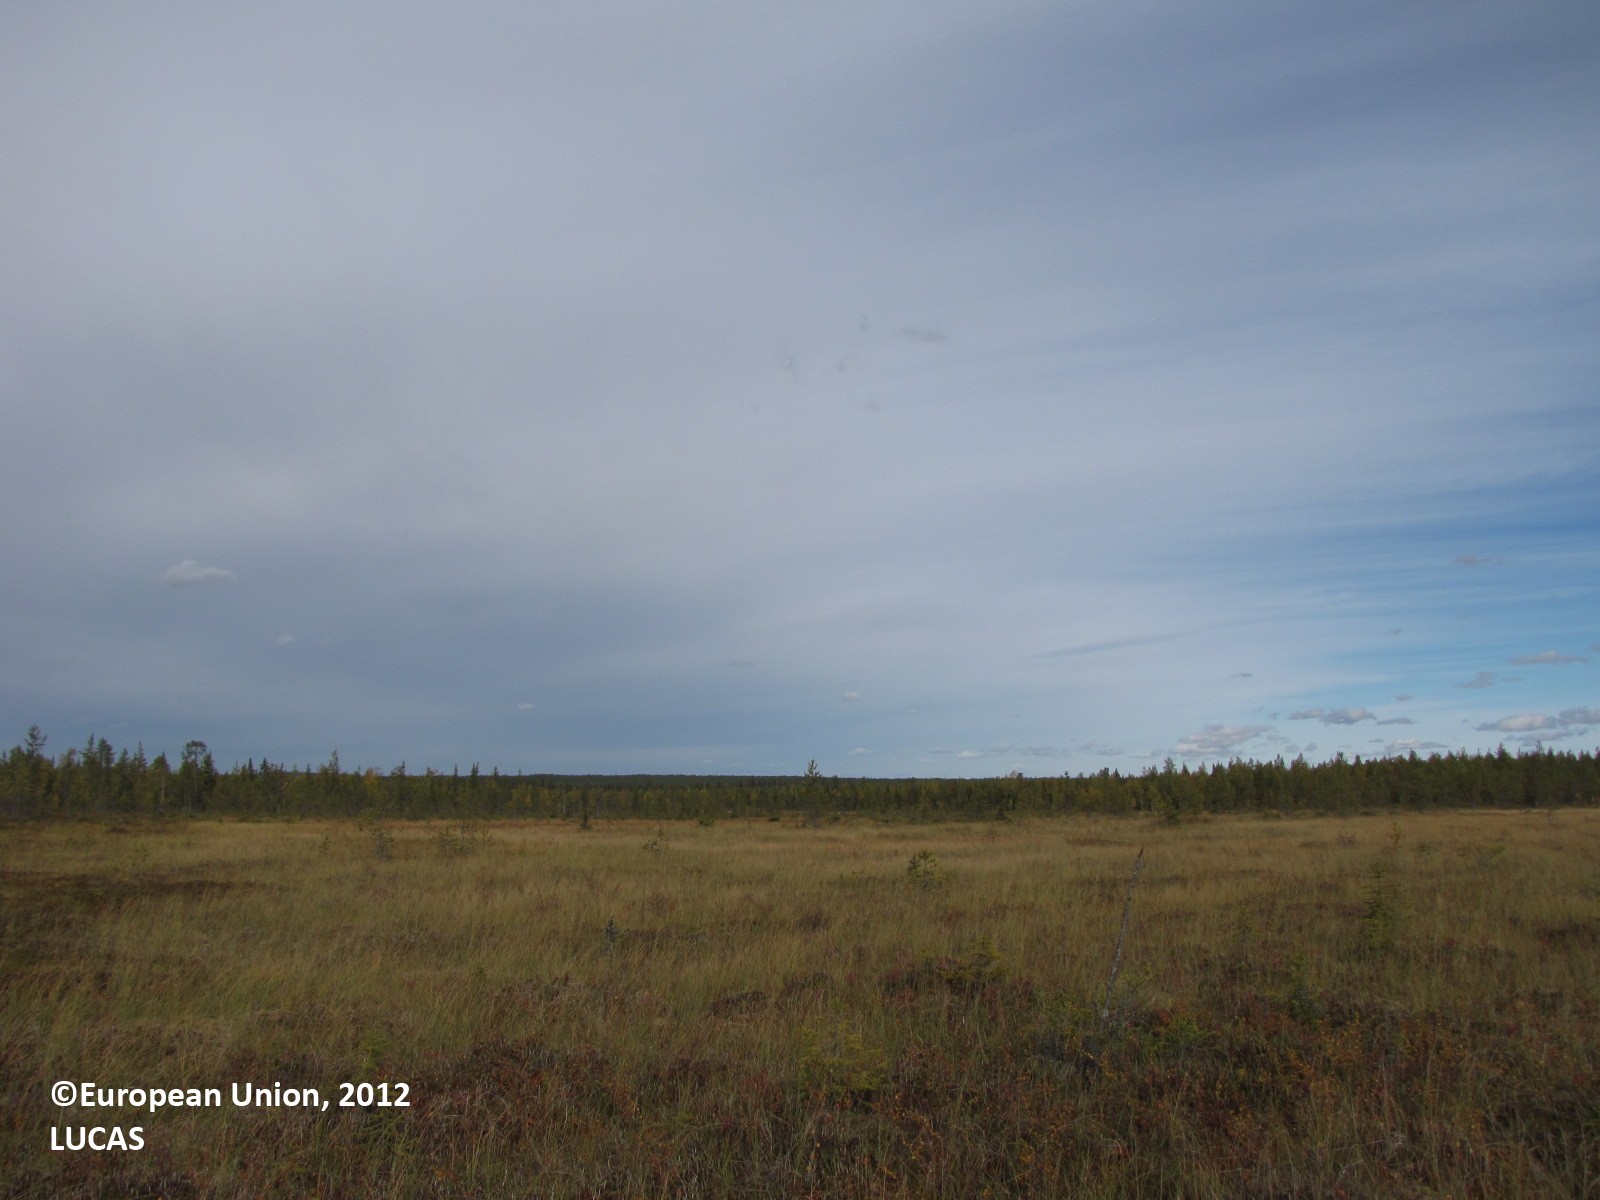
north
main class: Woodland
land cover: Pine dominated coniferous woodland
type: boreal forest
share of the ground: 10 - 25 %
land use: Forestry
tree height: < 5 m
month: September
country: FI
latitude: 67.1478
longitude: 24.8794
